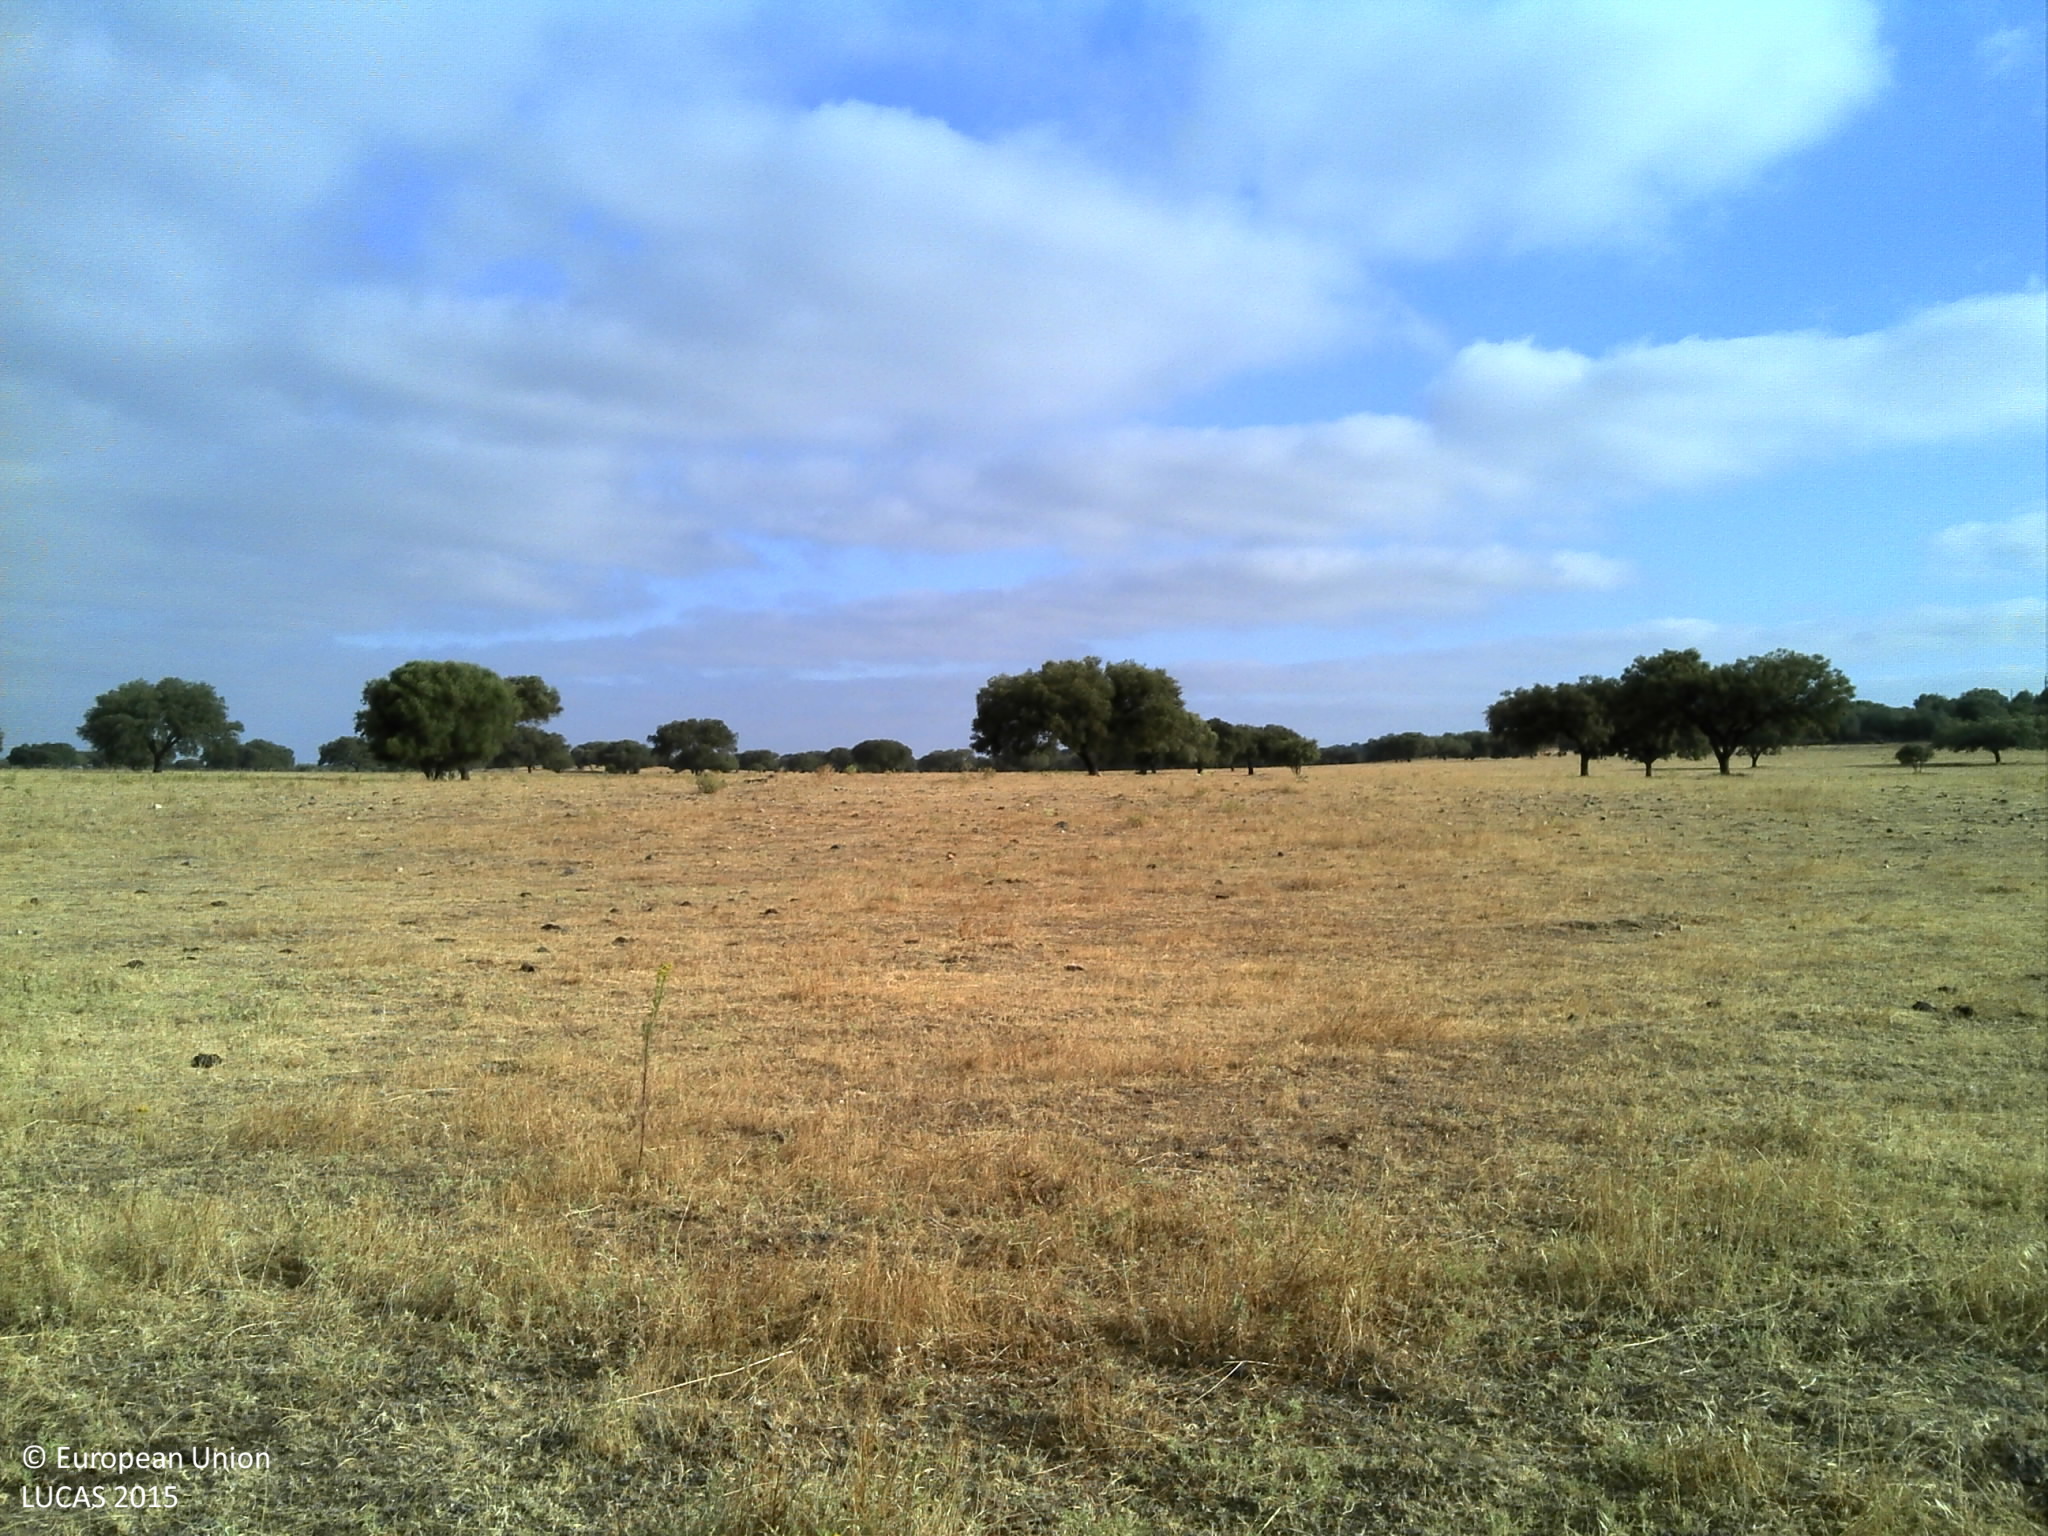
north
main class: Grassland
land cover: Grassland without tree/shrub cover
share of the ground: 10 - 25 %
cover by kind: unconsolidated bare surface 90 %, herbaceous plants 10 %
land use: Agriculture (excluding fallow land and kitchen gardens)
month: June
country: PT
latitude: 38.2120
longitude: -7.9298
